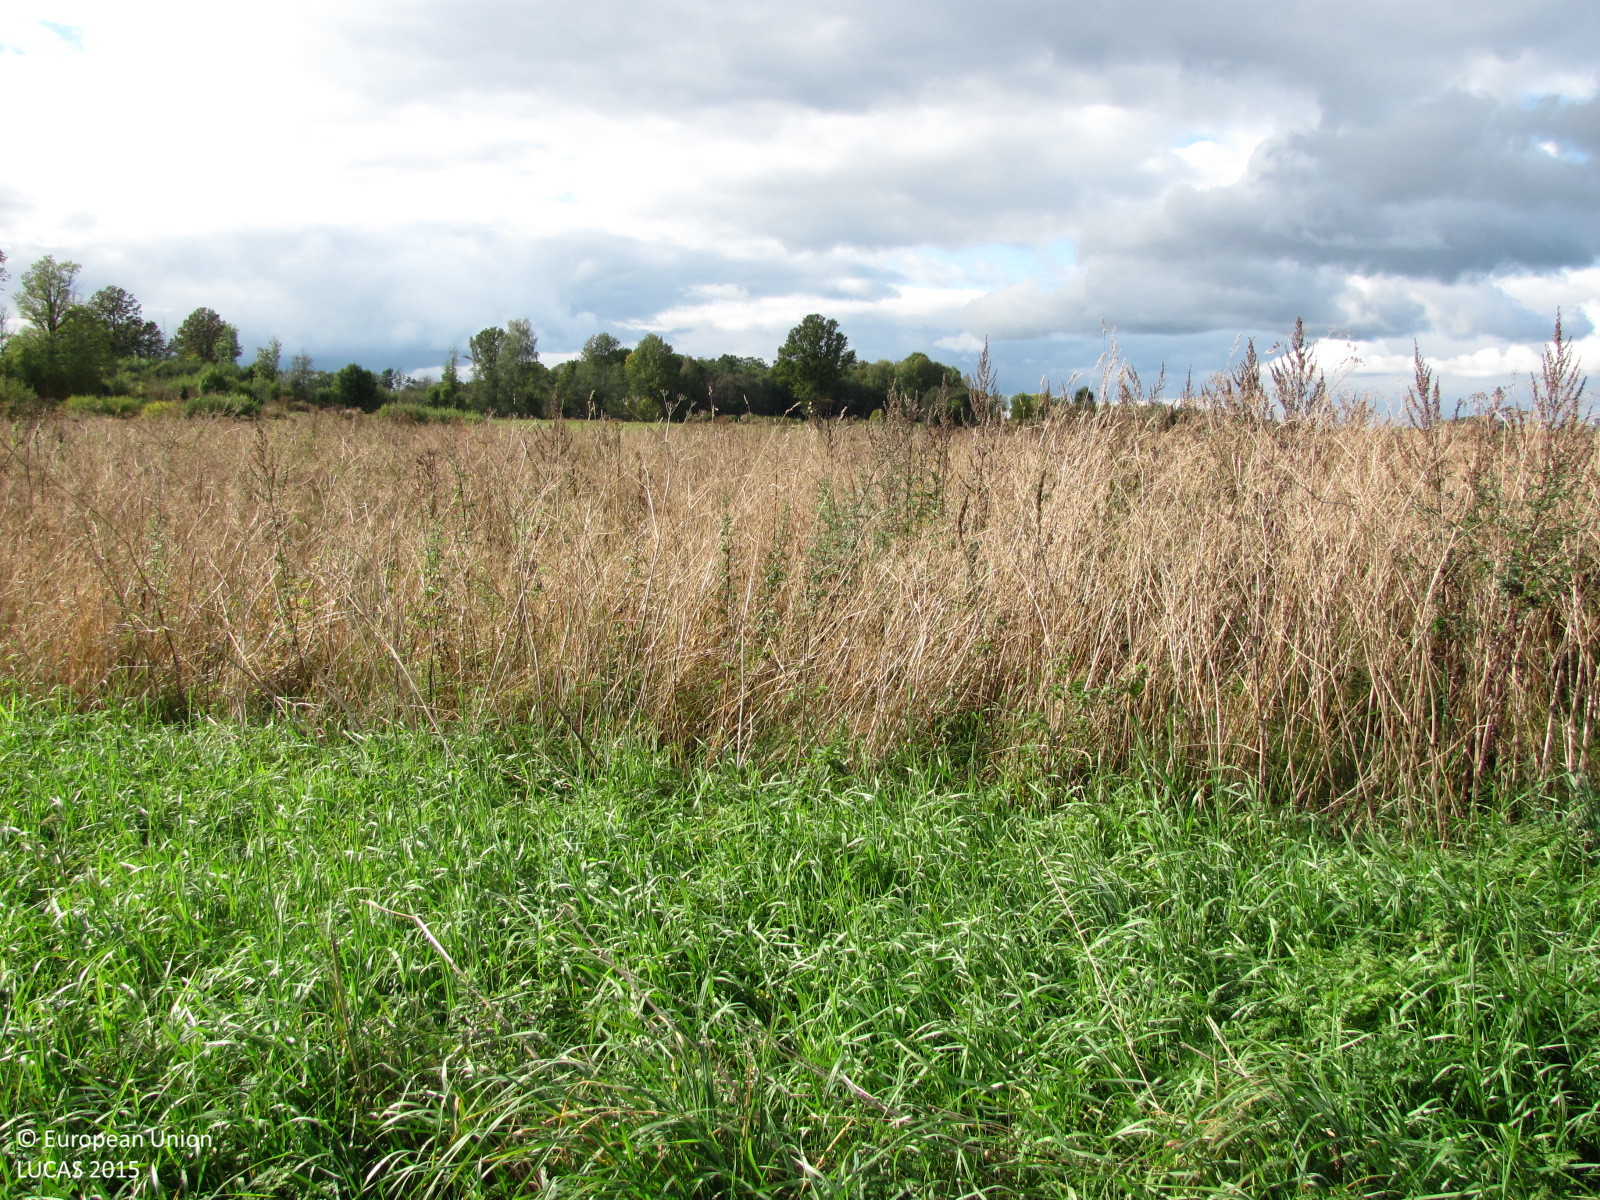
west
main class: Grassland
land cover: Grassland without tree/shrub cover
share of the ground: > 75 %
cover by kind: herbaceous plants 100 %
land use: Agriculture (excluding fallow land and kitchen gardens)
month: September
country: LV
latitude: 56.8328
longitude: 25.2056
